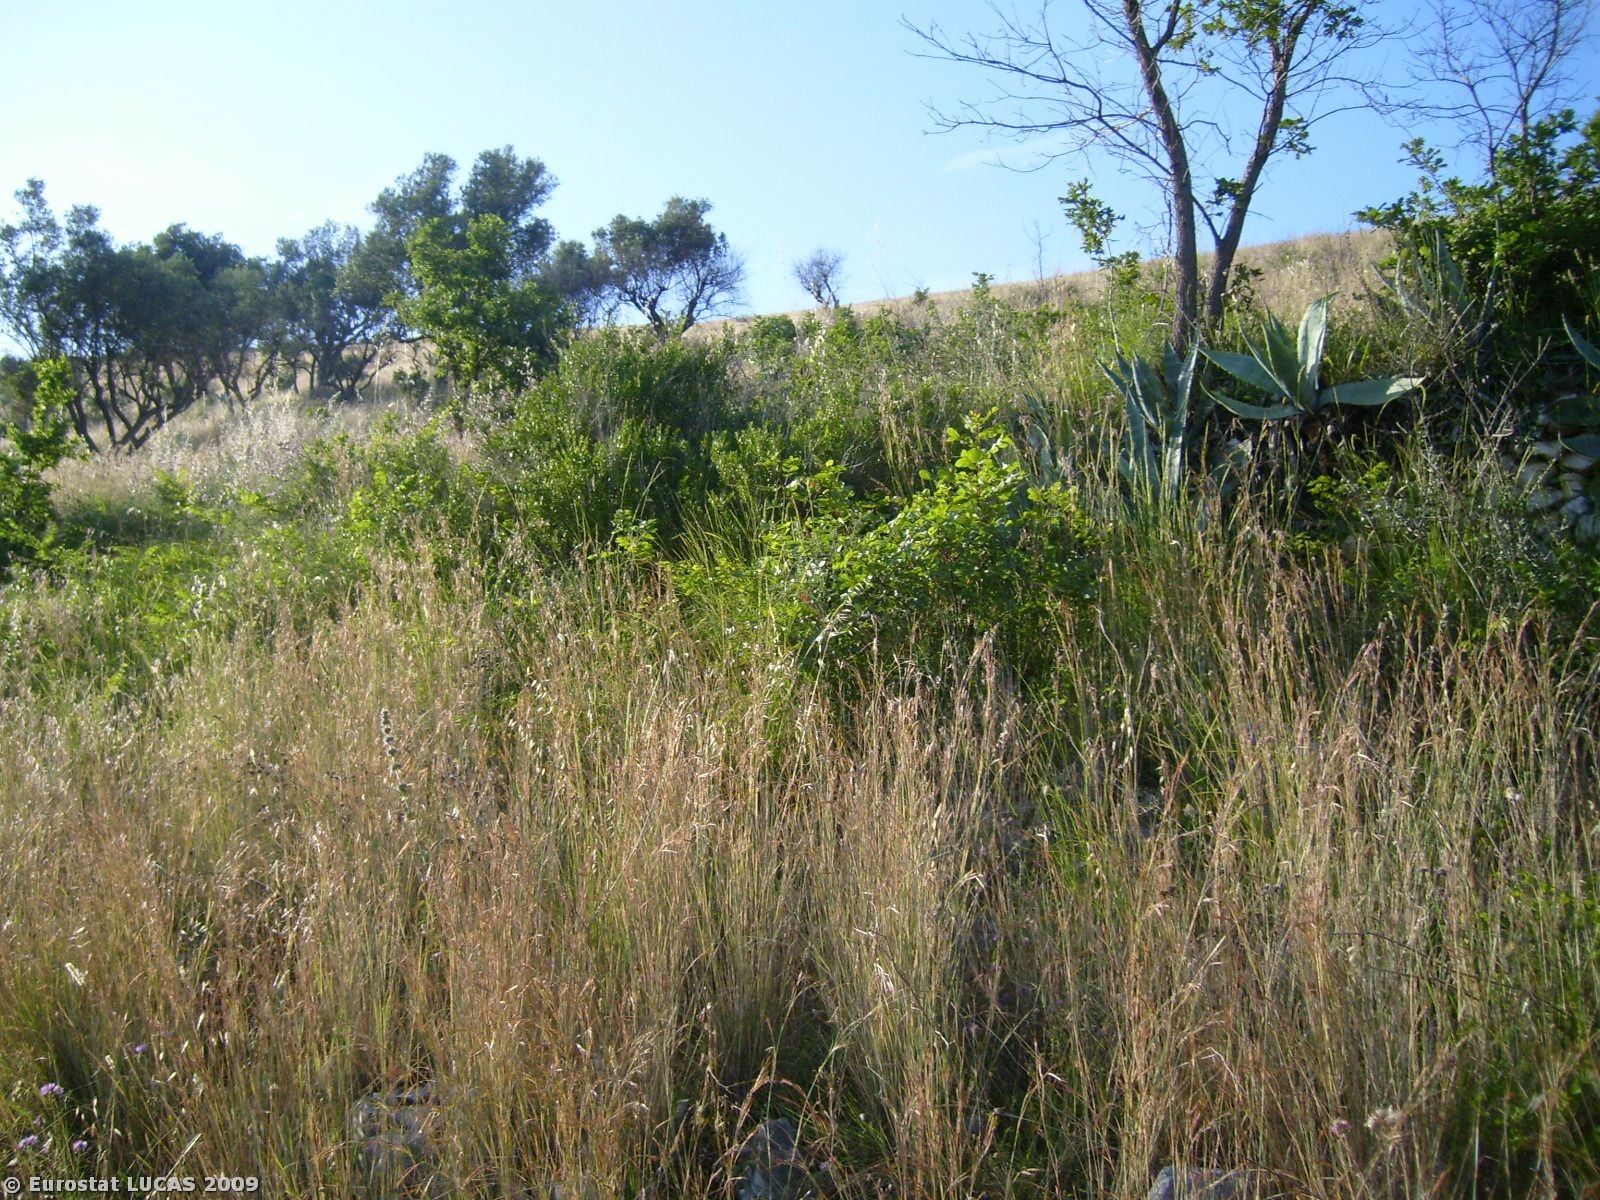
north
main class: Shrubland
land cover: Shrubland with sparse tree cover
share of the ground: > 75 %
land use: Fallow land
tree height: < 5 m
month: June
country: IT
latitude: 41.1319
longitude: 14.3310
